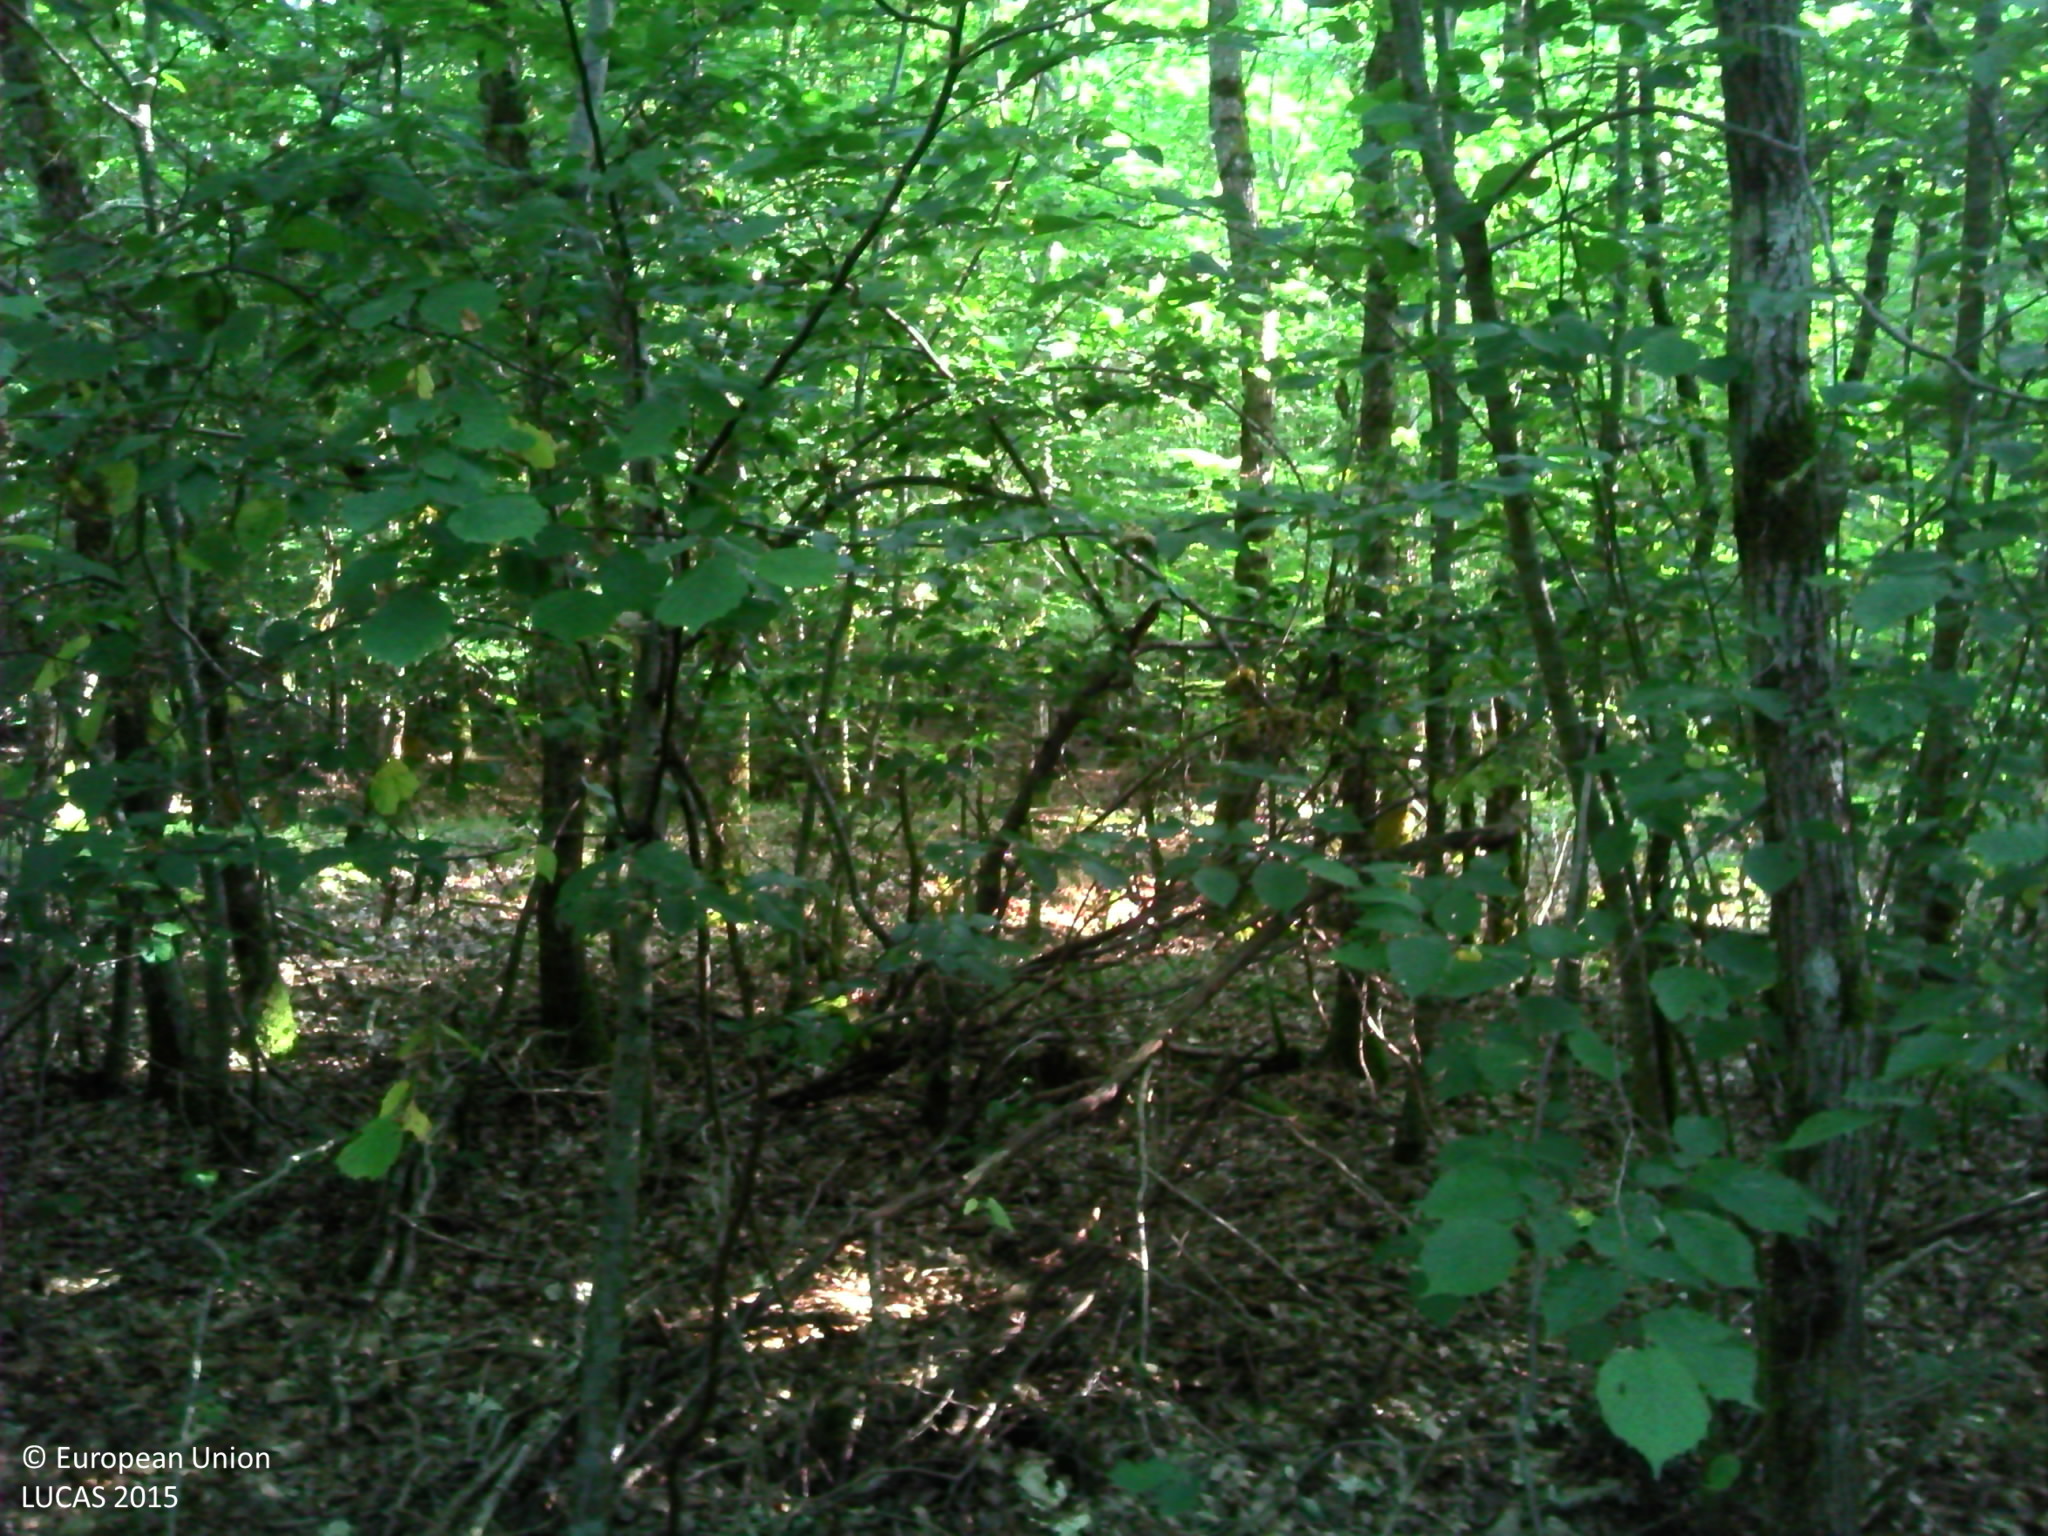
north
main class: Woodland
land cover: Broadleaved woodland
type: acidophilous oak and oak-birch forest
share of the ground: > 75 %
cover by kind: broadleaved forest trees 90 %, herbaceous plants 5 %, lichens and mosses 5 %
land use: Forestry
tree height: > 5 m
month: July
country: FR
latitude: 48.5305
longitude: 6.0322
